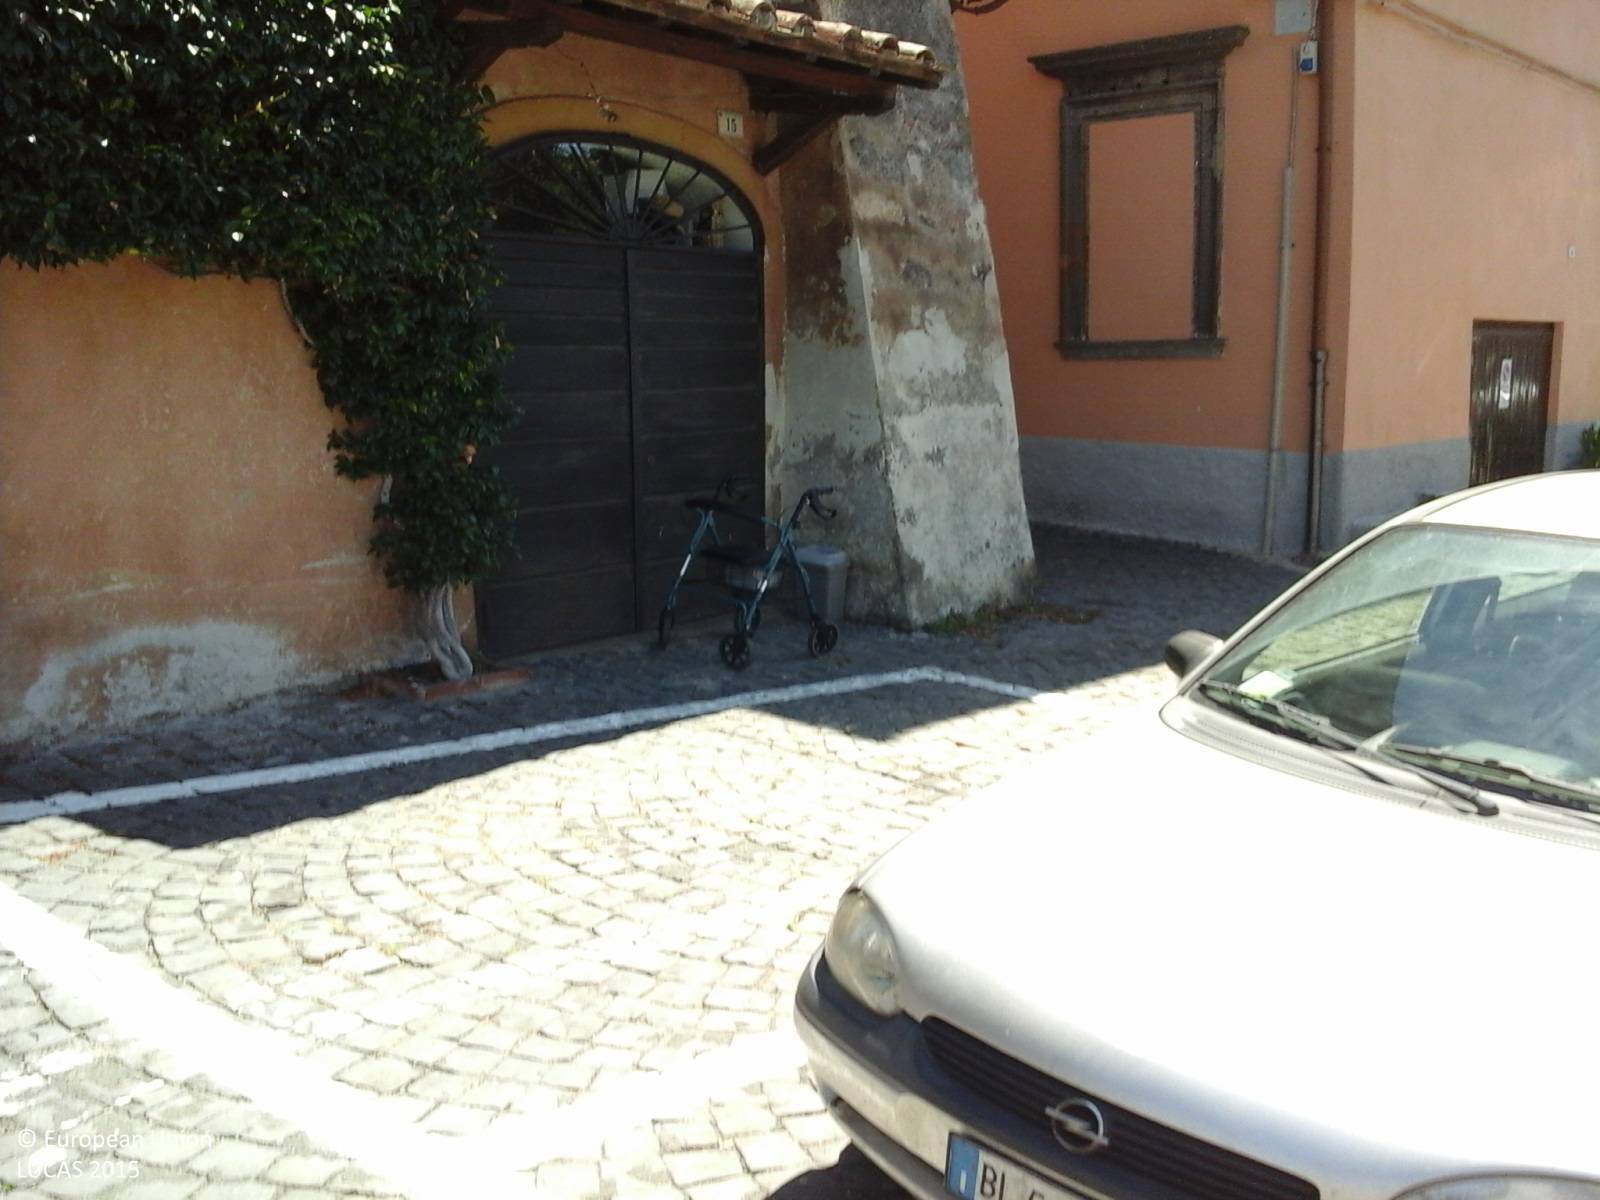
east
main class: Woodland
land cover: Broadleaved woodland
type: thermophilous deciduous forest
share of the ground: > 75 %
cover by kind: broadleaved forest trees 100 %
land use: Forestry
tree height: > 5 m
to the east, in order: Broadleaved woodland
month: August
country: IT
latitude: 41.9986
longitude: 12.1530
